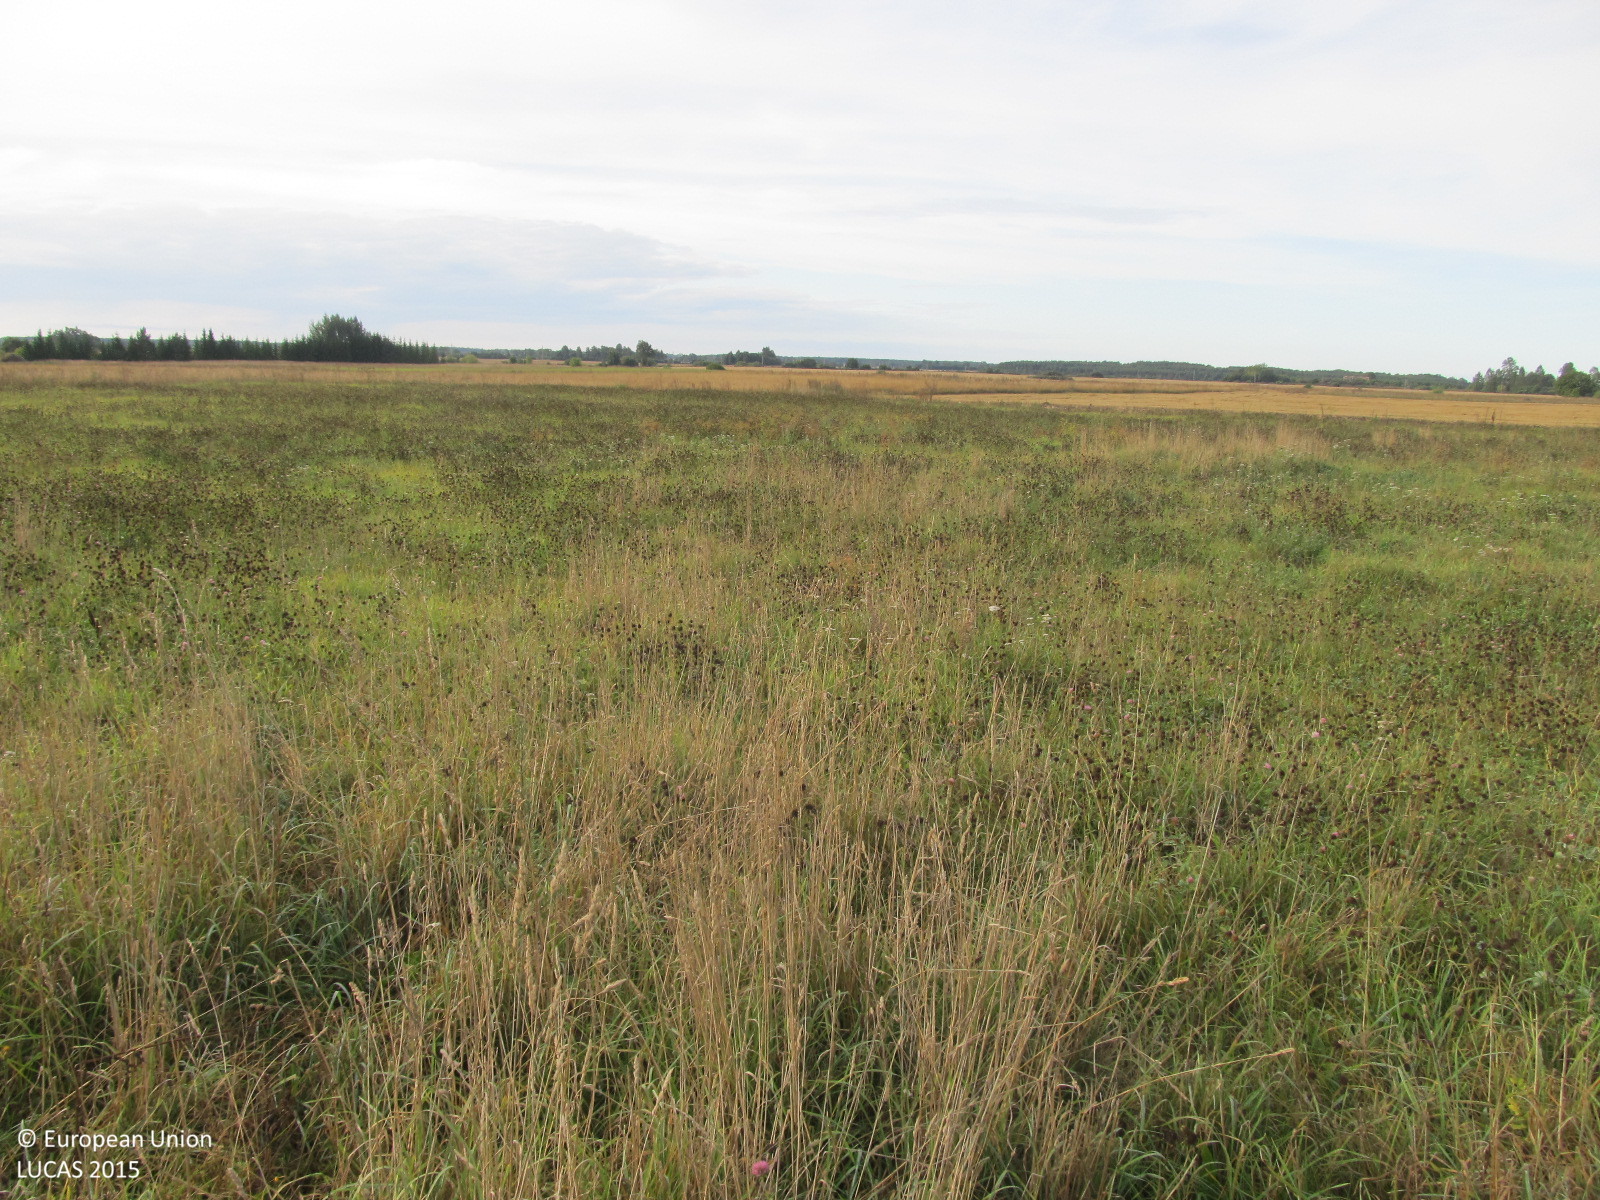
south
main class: Grassland
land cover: Grassland without tree/shrub cover
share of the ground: > 75 %
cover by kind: herbaceous plants 100 %
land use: Agriculture (excluding fallow land and kitchen gardens)
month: September
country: LT
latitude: 56.3115
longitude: 23.3116
